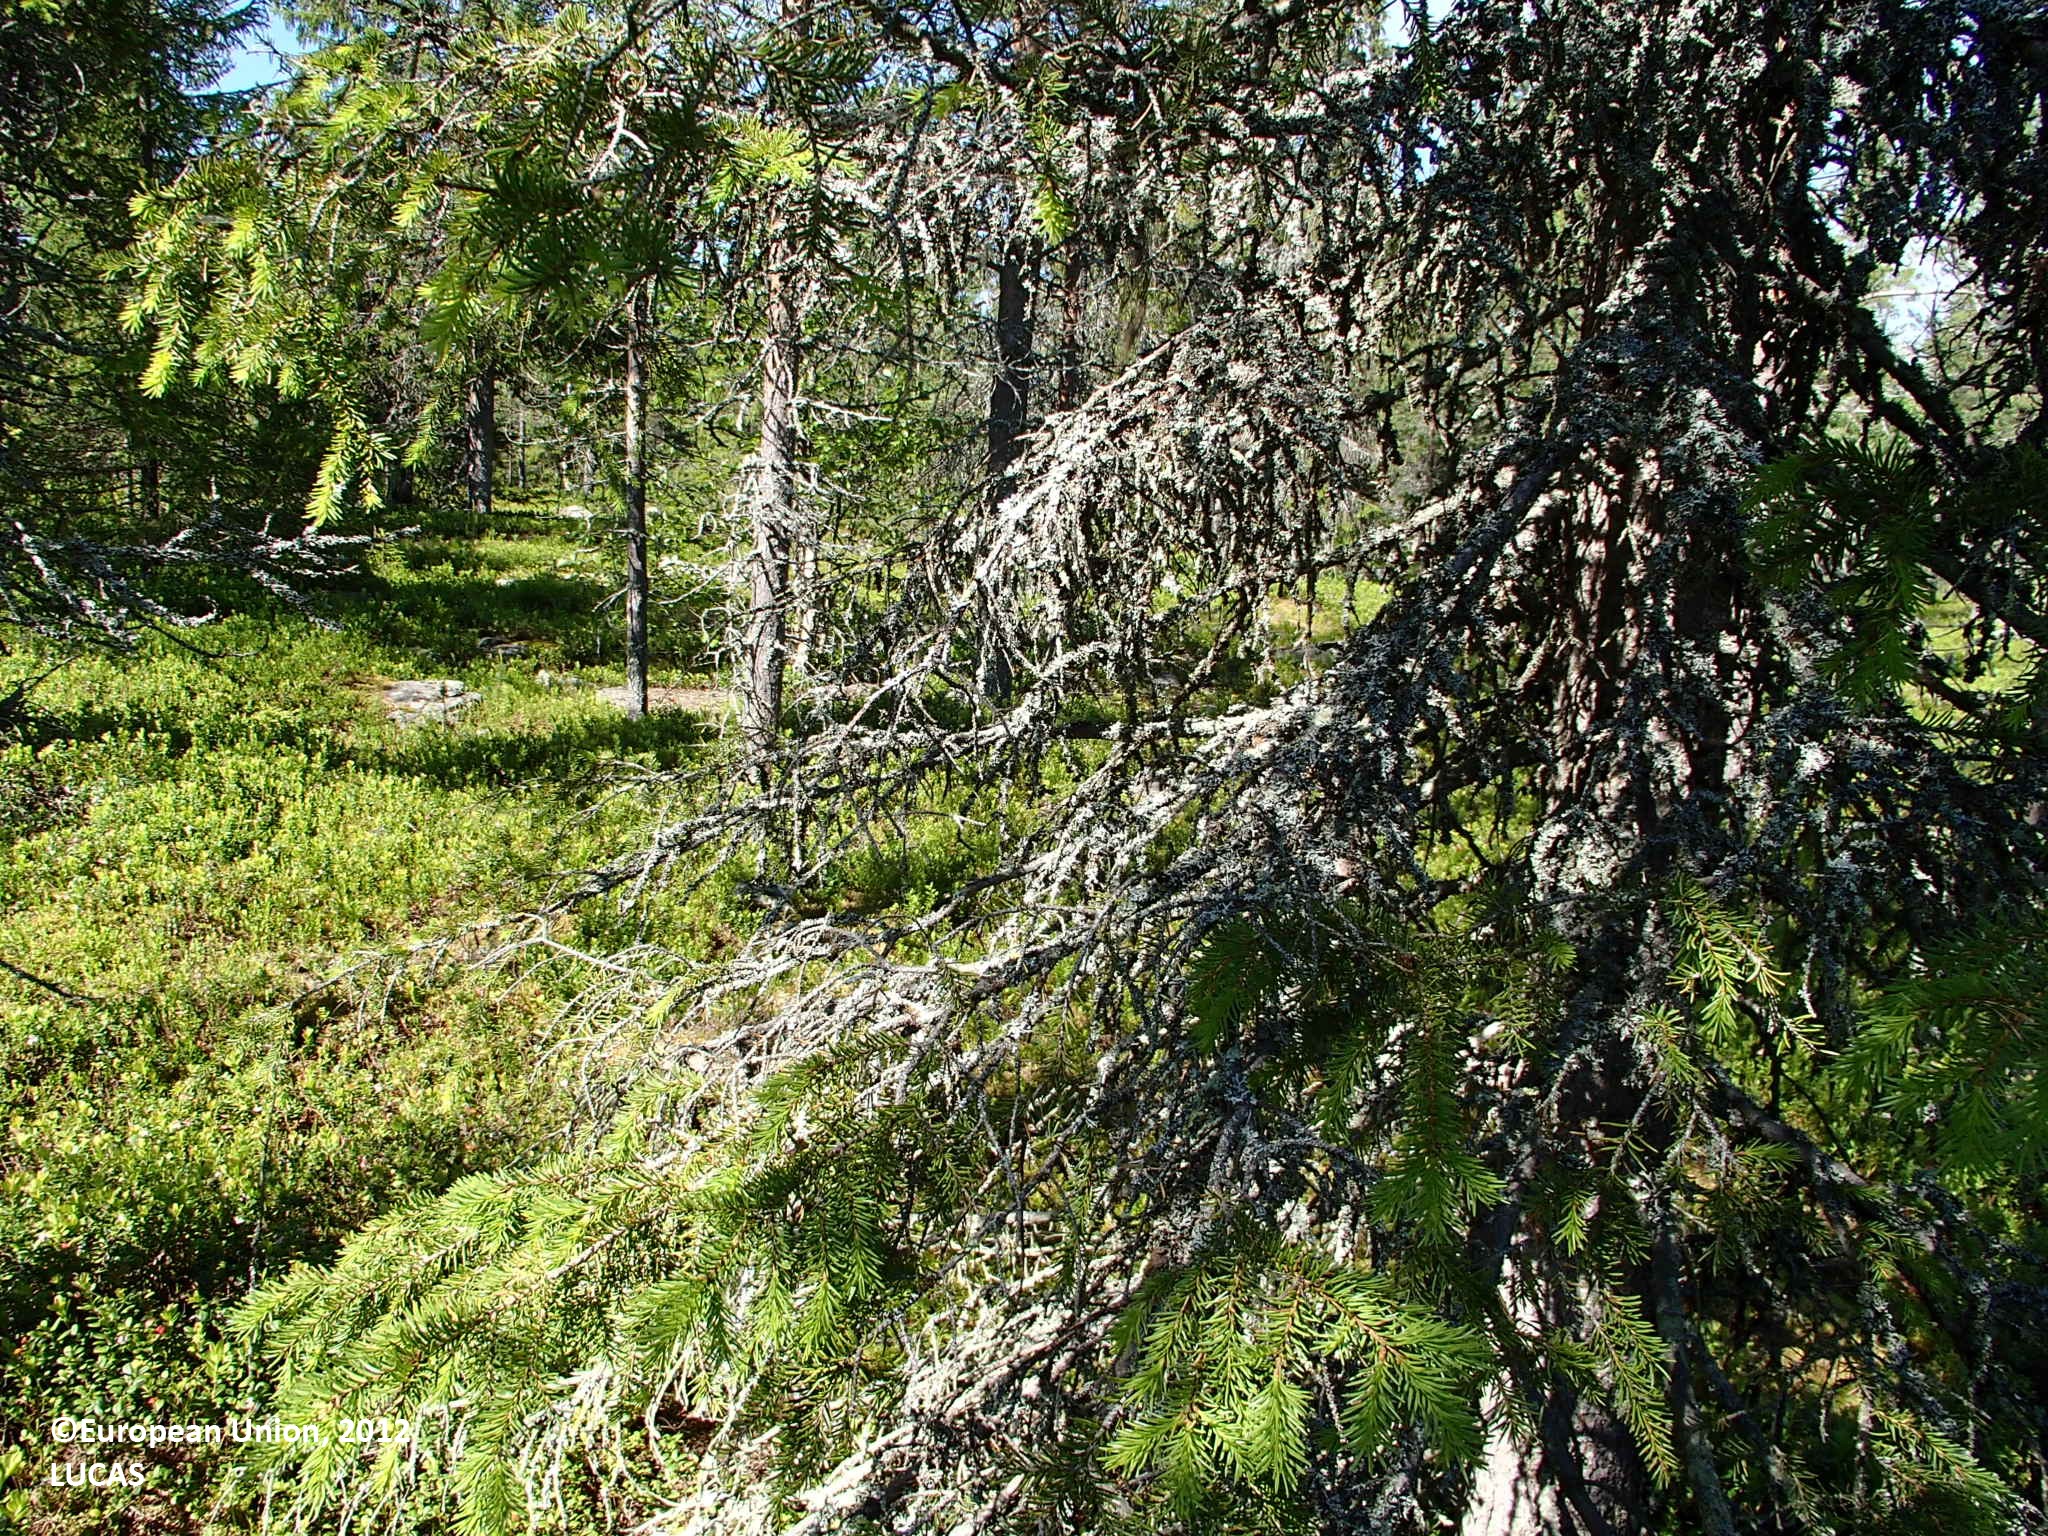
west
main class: Woodland
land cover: Other coniferous woodland
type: boreal forest
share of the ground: > 75 %
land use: Forestry
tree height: > 5 m
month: July
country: FI
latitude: 67.3405
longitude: 26.0431
